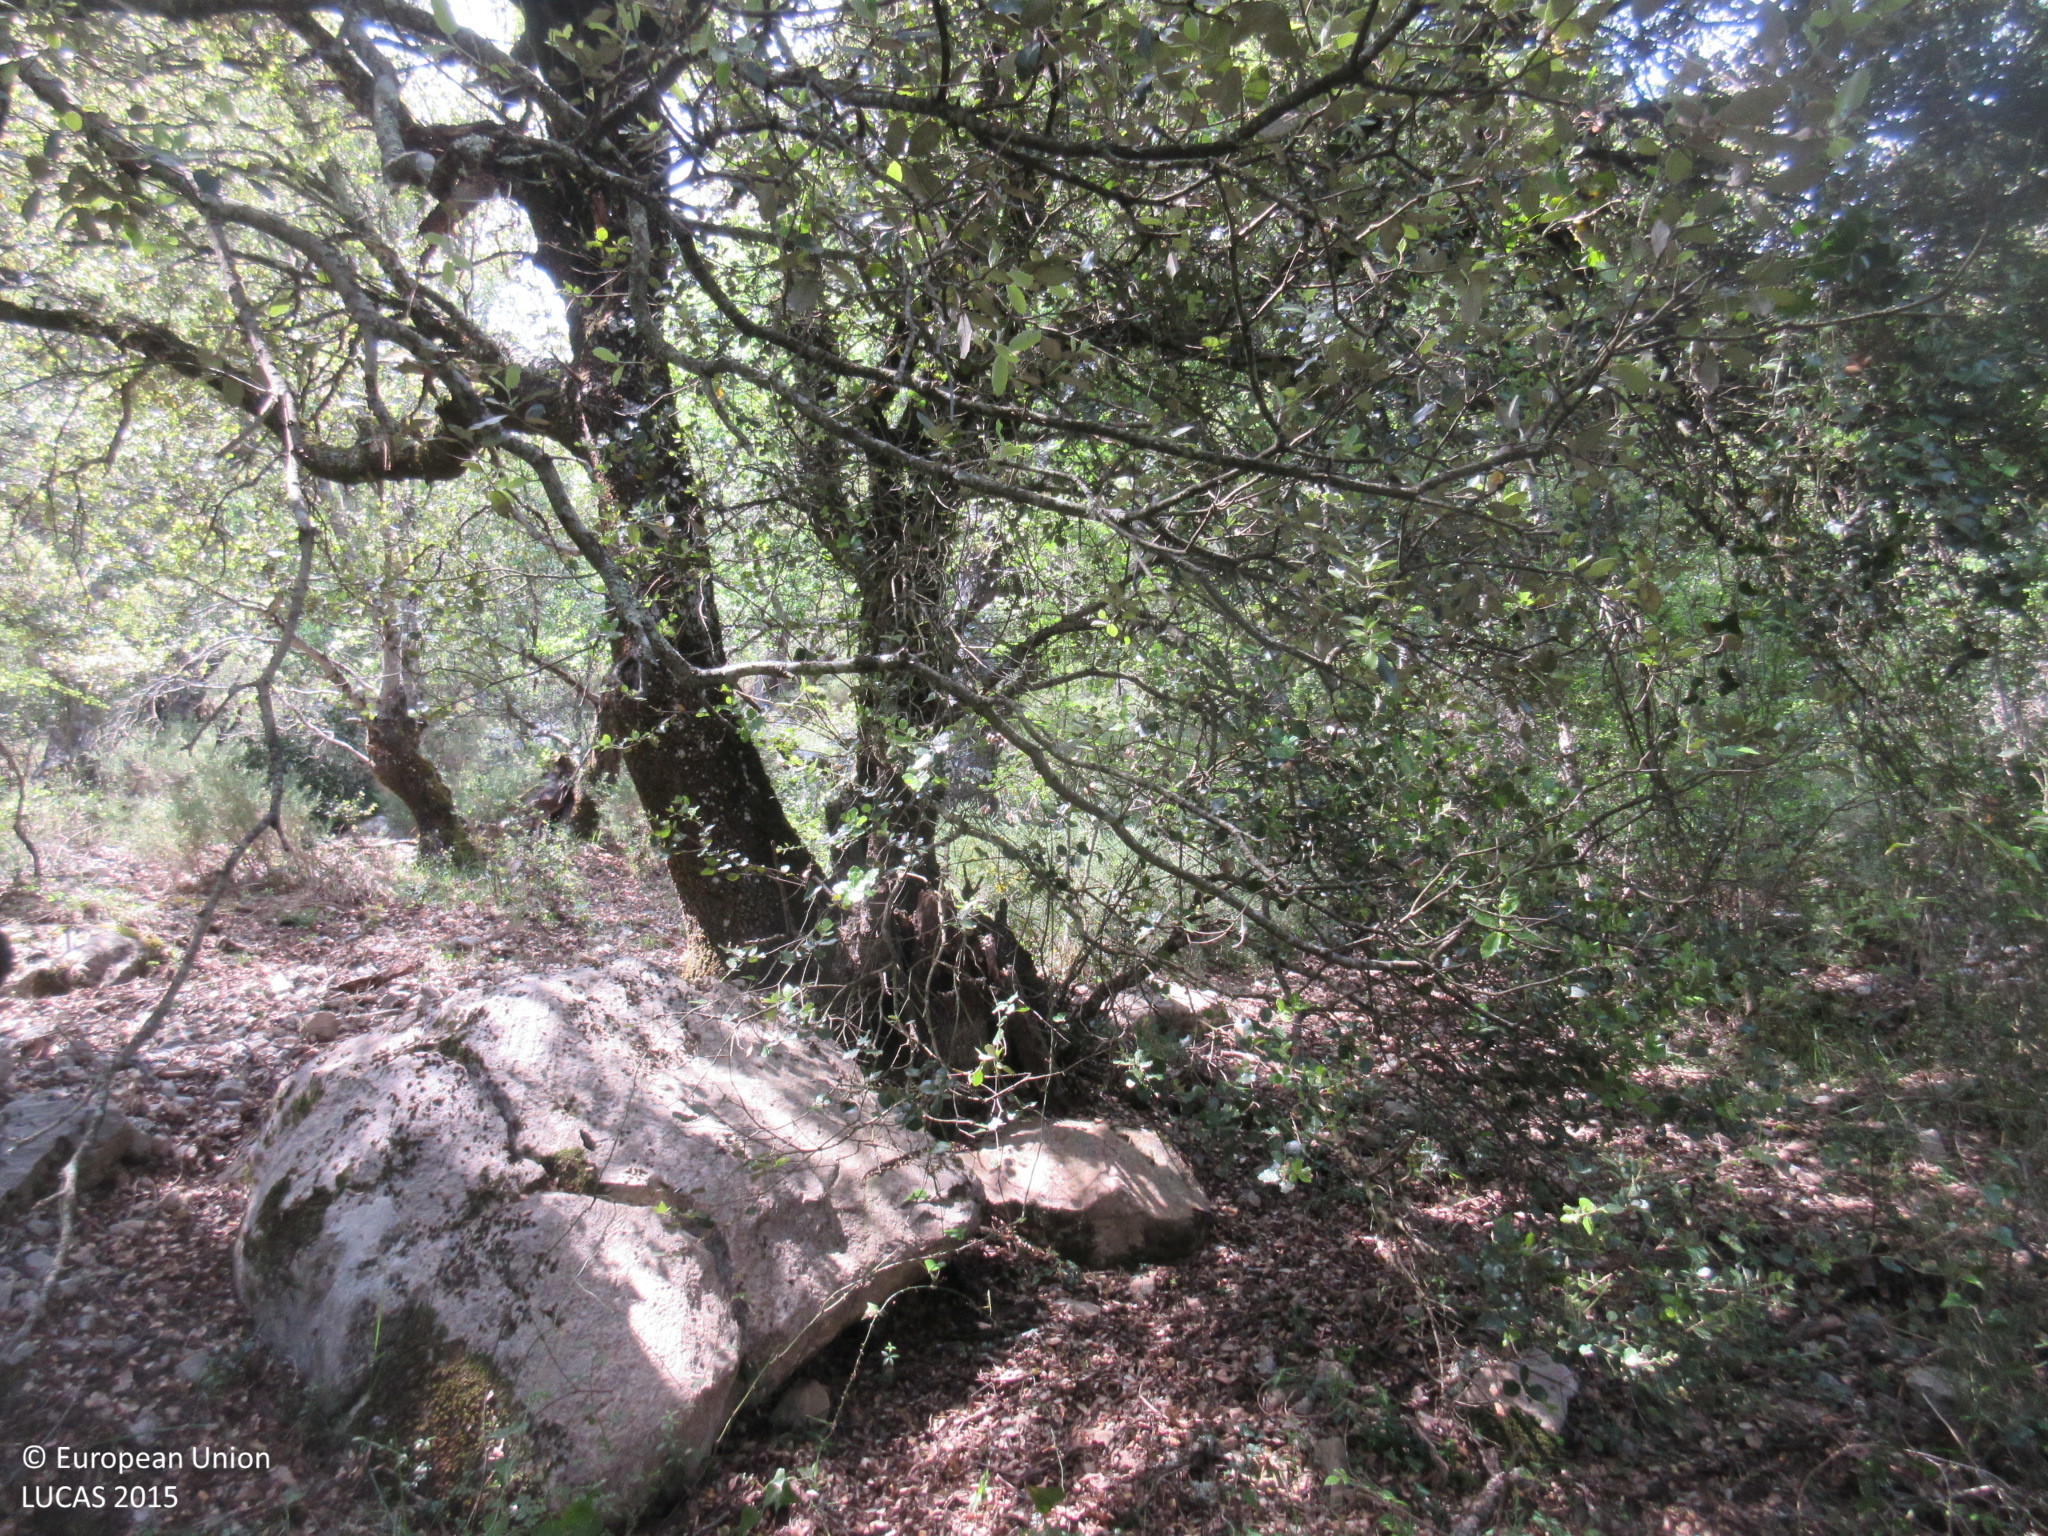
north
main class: Woodland
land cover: Broadleaved woodland
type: broadleaved evergreen forest
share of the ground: > 75 %
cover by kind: broadleaved forest trees 90 %, shrubs 10 %
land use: Agriculture (excluding fallow land and kitchen gardens)
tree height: > 5 m
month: May
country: ES
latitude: 43.2199
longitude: -4.5996
